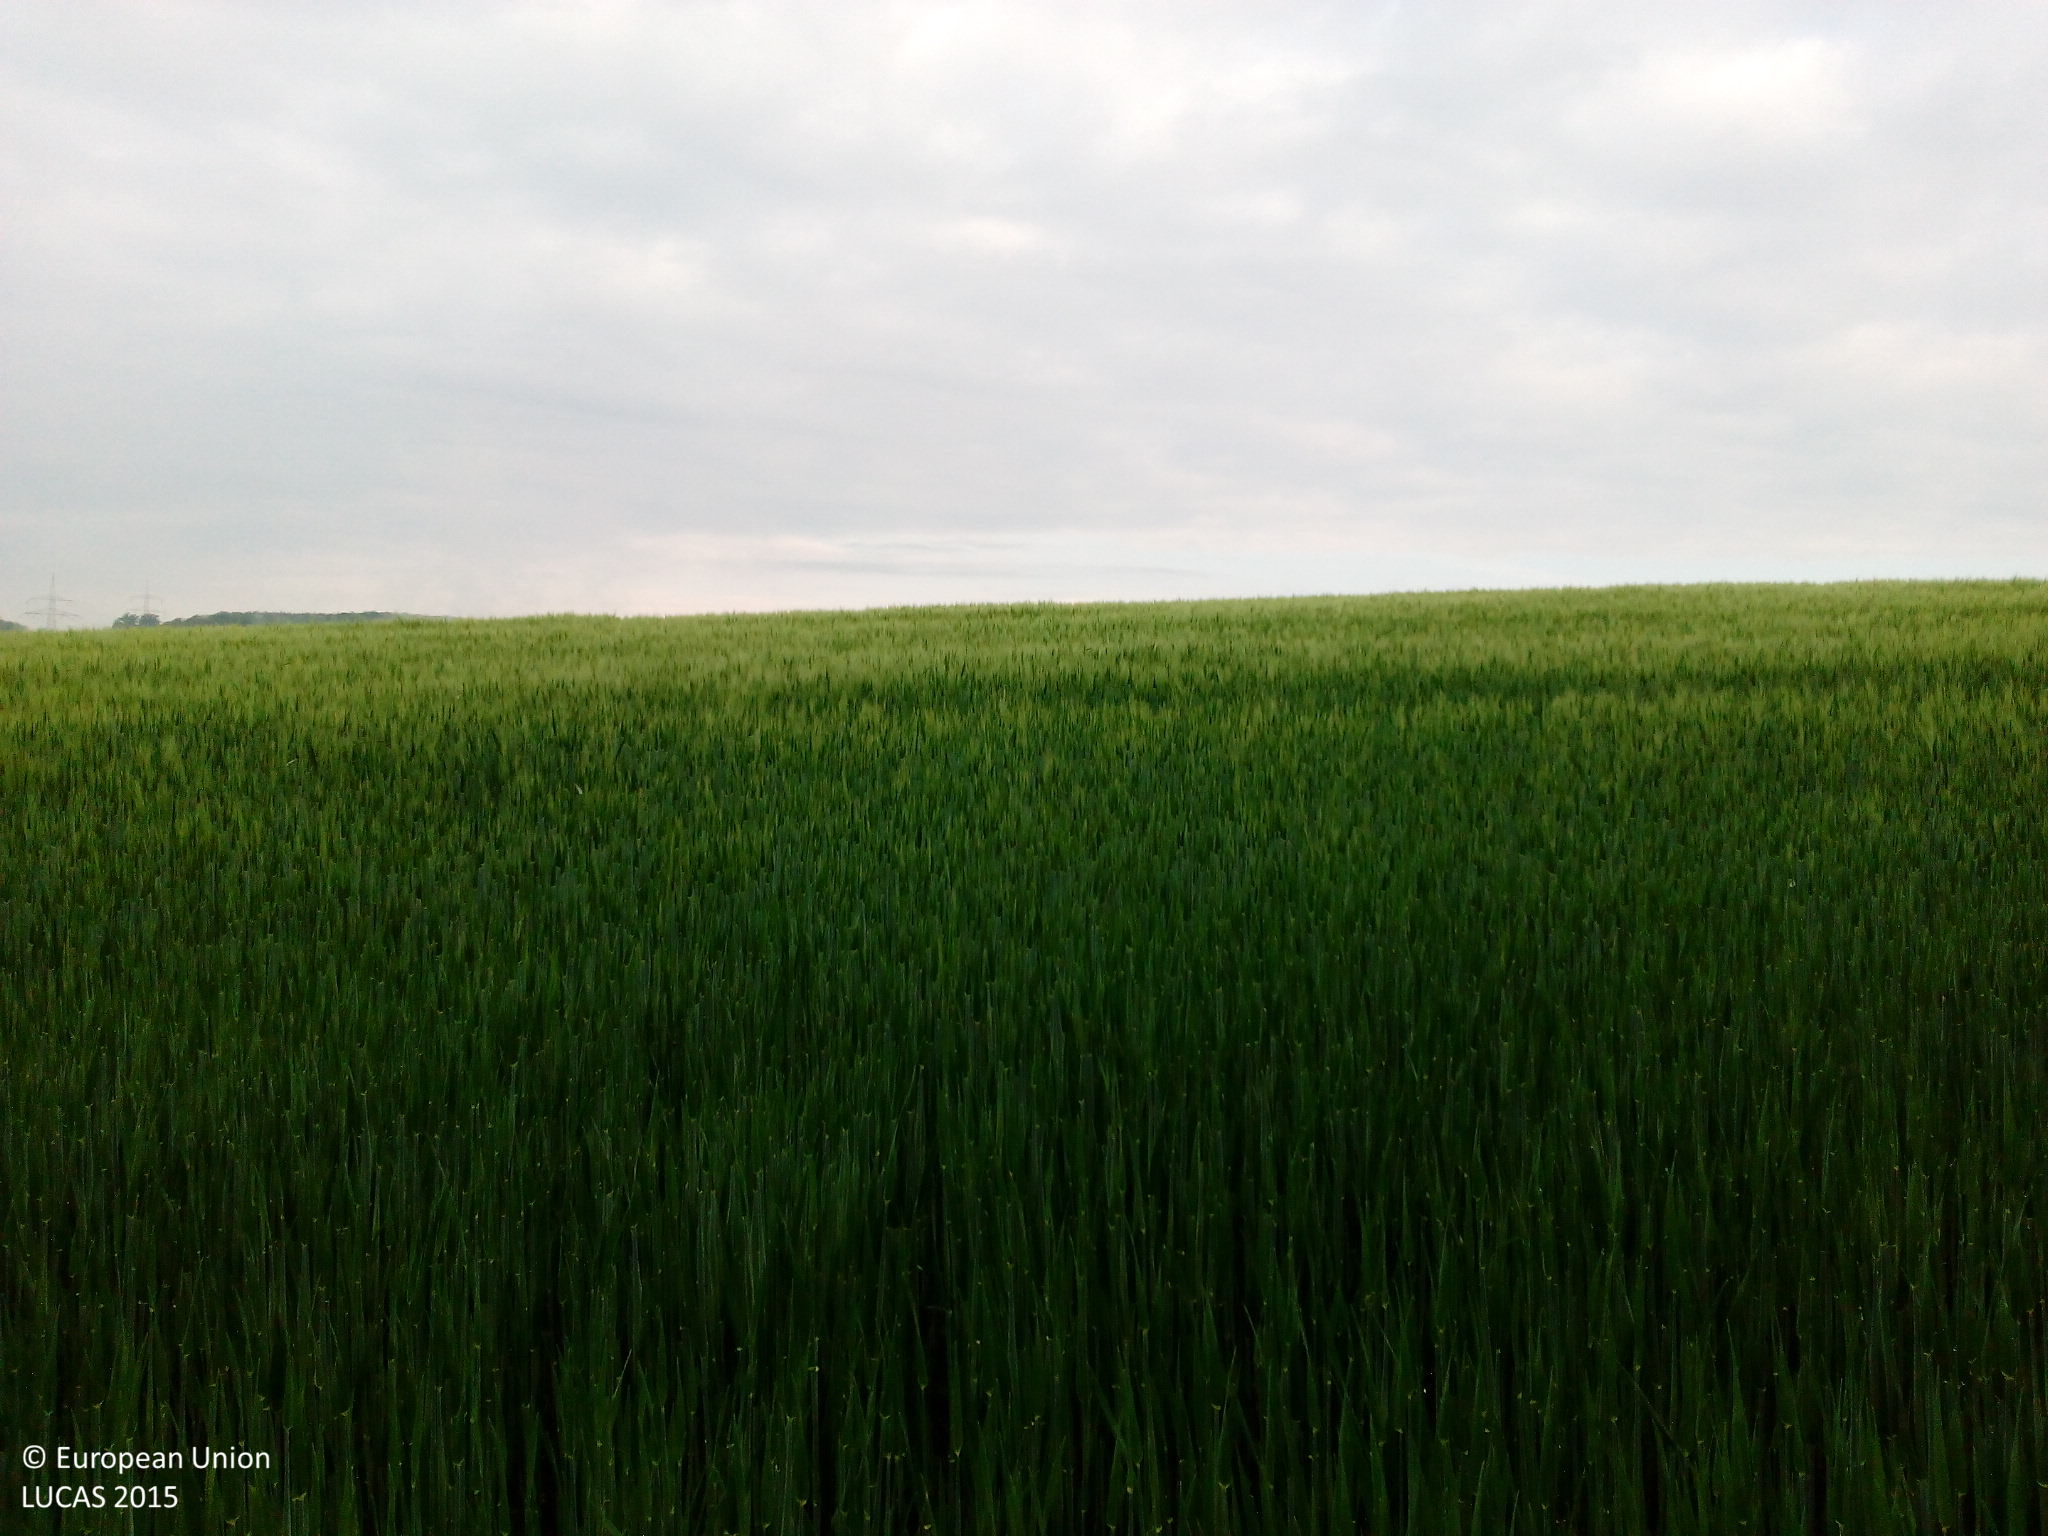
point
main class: Cropland
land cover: Barley
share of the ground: > 75 %
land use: Agriculture (excluding fallow land and kitchen gardens)
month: May
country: DE
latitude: 50.6109
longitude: 13.0666
